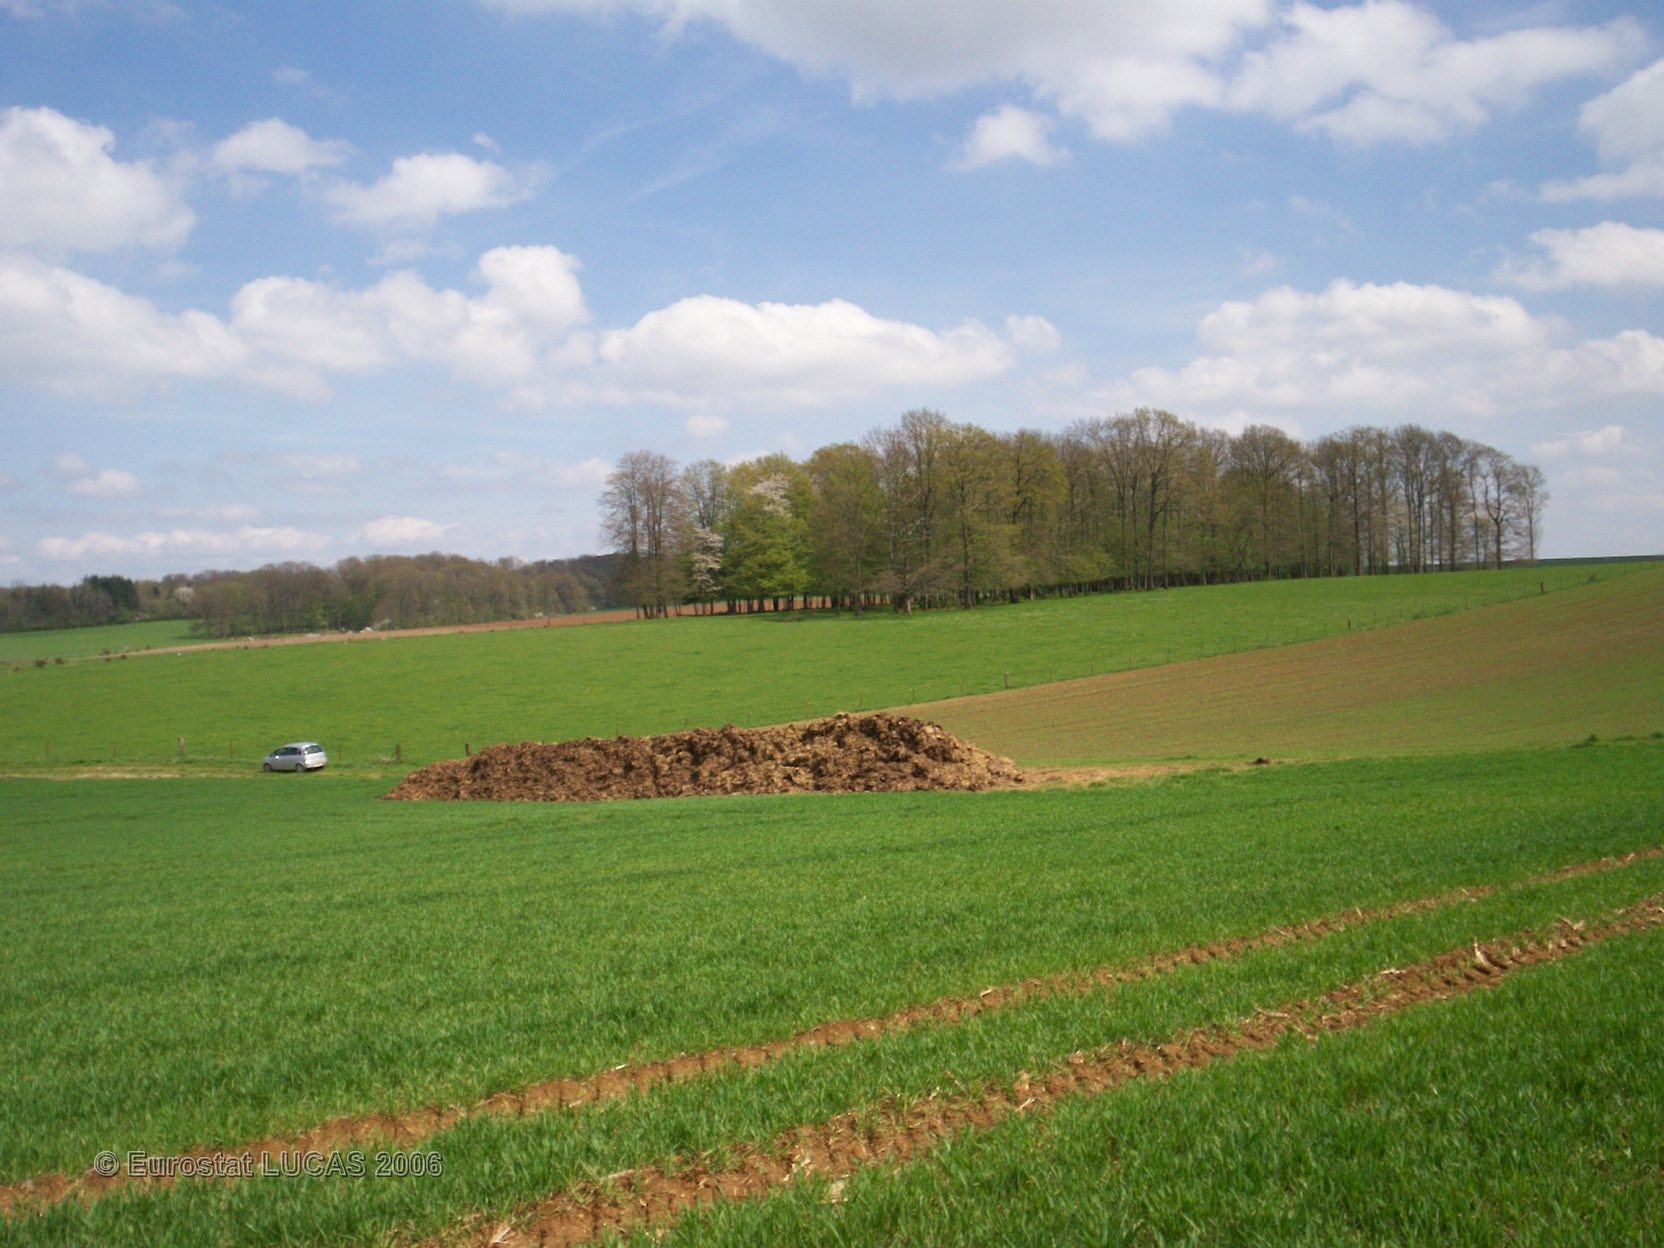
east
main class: Cropland
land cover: Common wheat
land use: Agriculture (excluding fallow land and kitchen gardens)
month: May
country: FR
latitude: 49.7928
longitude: 4.3697
